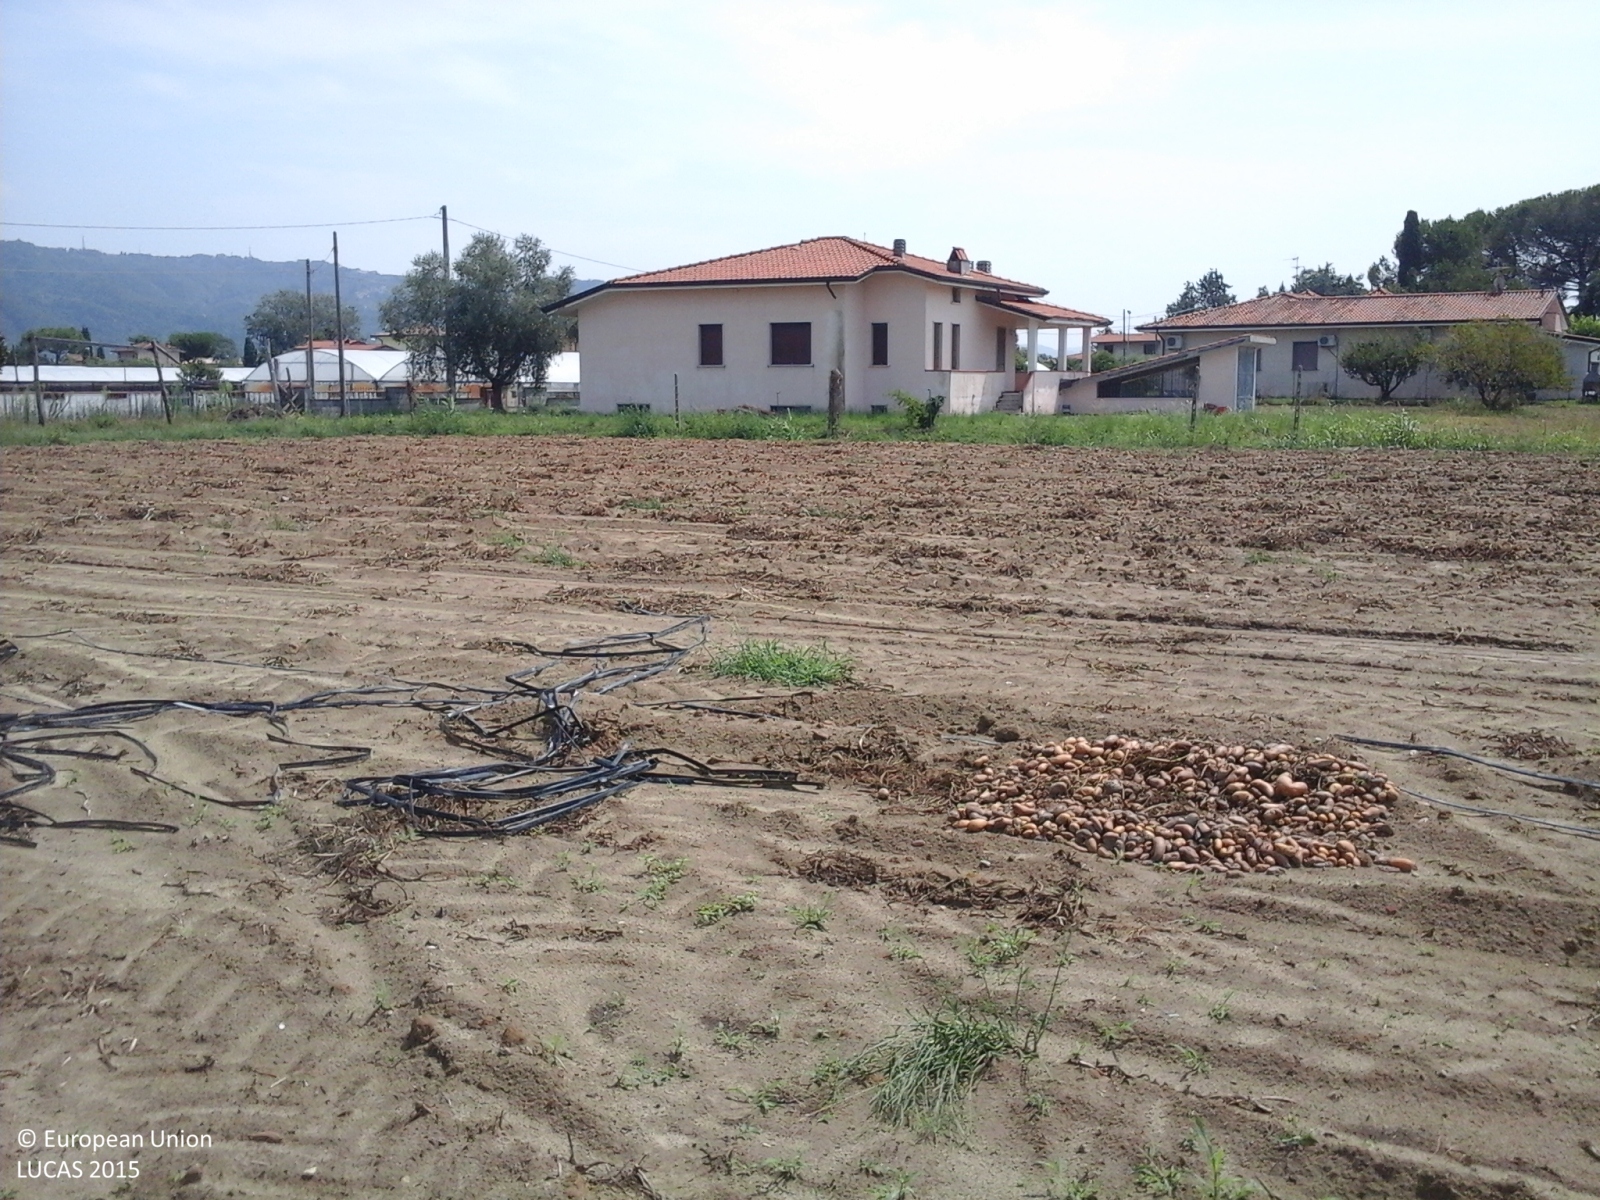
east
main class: Cropland
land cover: Potatoes
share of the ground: > 75 %
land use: Agriculture (excluding fallow land and kitchen gardens)
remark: Harvested field
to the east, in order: Potatoes; Ditches and canals; Grass margins; Paved roads, cycling and walking lanes; Grass margins; Fences; Grassland without tree/shrub cover; Artificial constructions in urban areas; Grassland without tree/shrub cover; Artificial constructions in urban areas
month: August
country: IT
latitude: 43.9173
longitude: 10.2360
